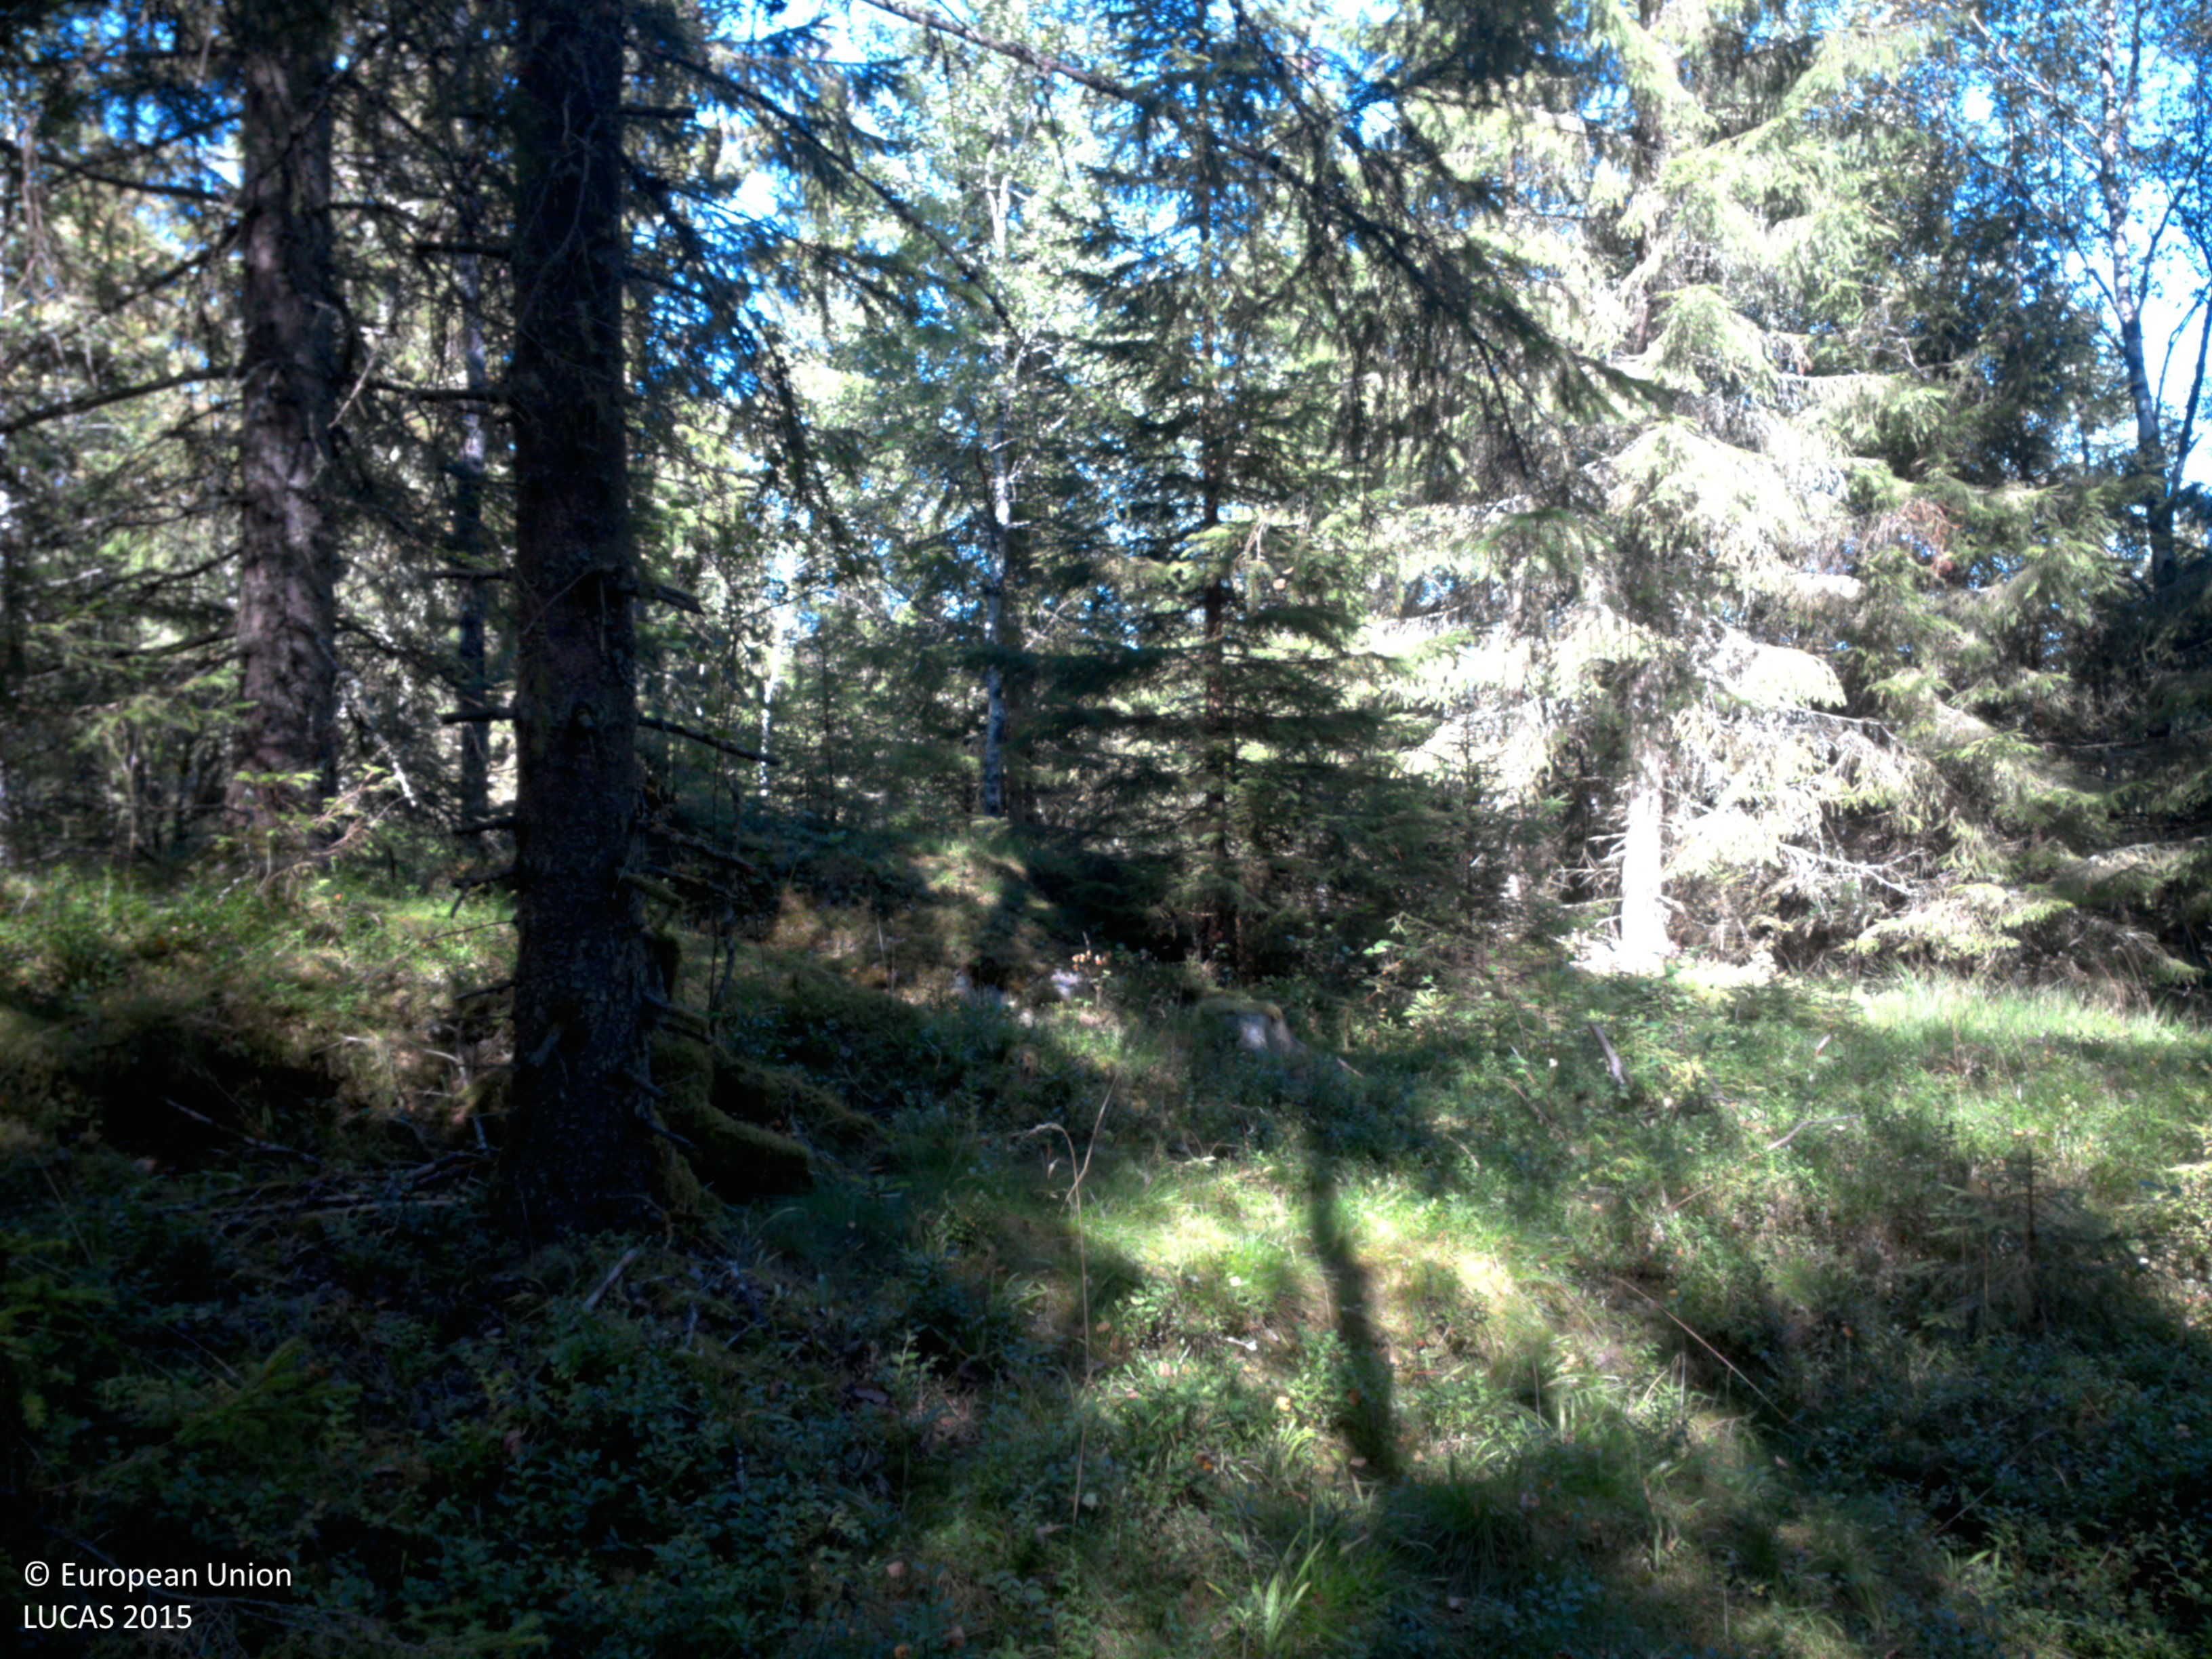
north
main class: Woodland
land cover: Spruce dominated mixed woodland
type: boreal forest
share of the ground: 50 - 75 %
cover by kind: coniferous forest trees 45 %, herbaceous plants 30 %, broadleaved forest trees 25 %
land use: Forestry
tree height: > 5 m
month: August
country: SE
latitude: 58.5474
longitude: 11.9375
